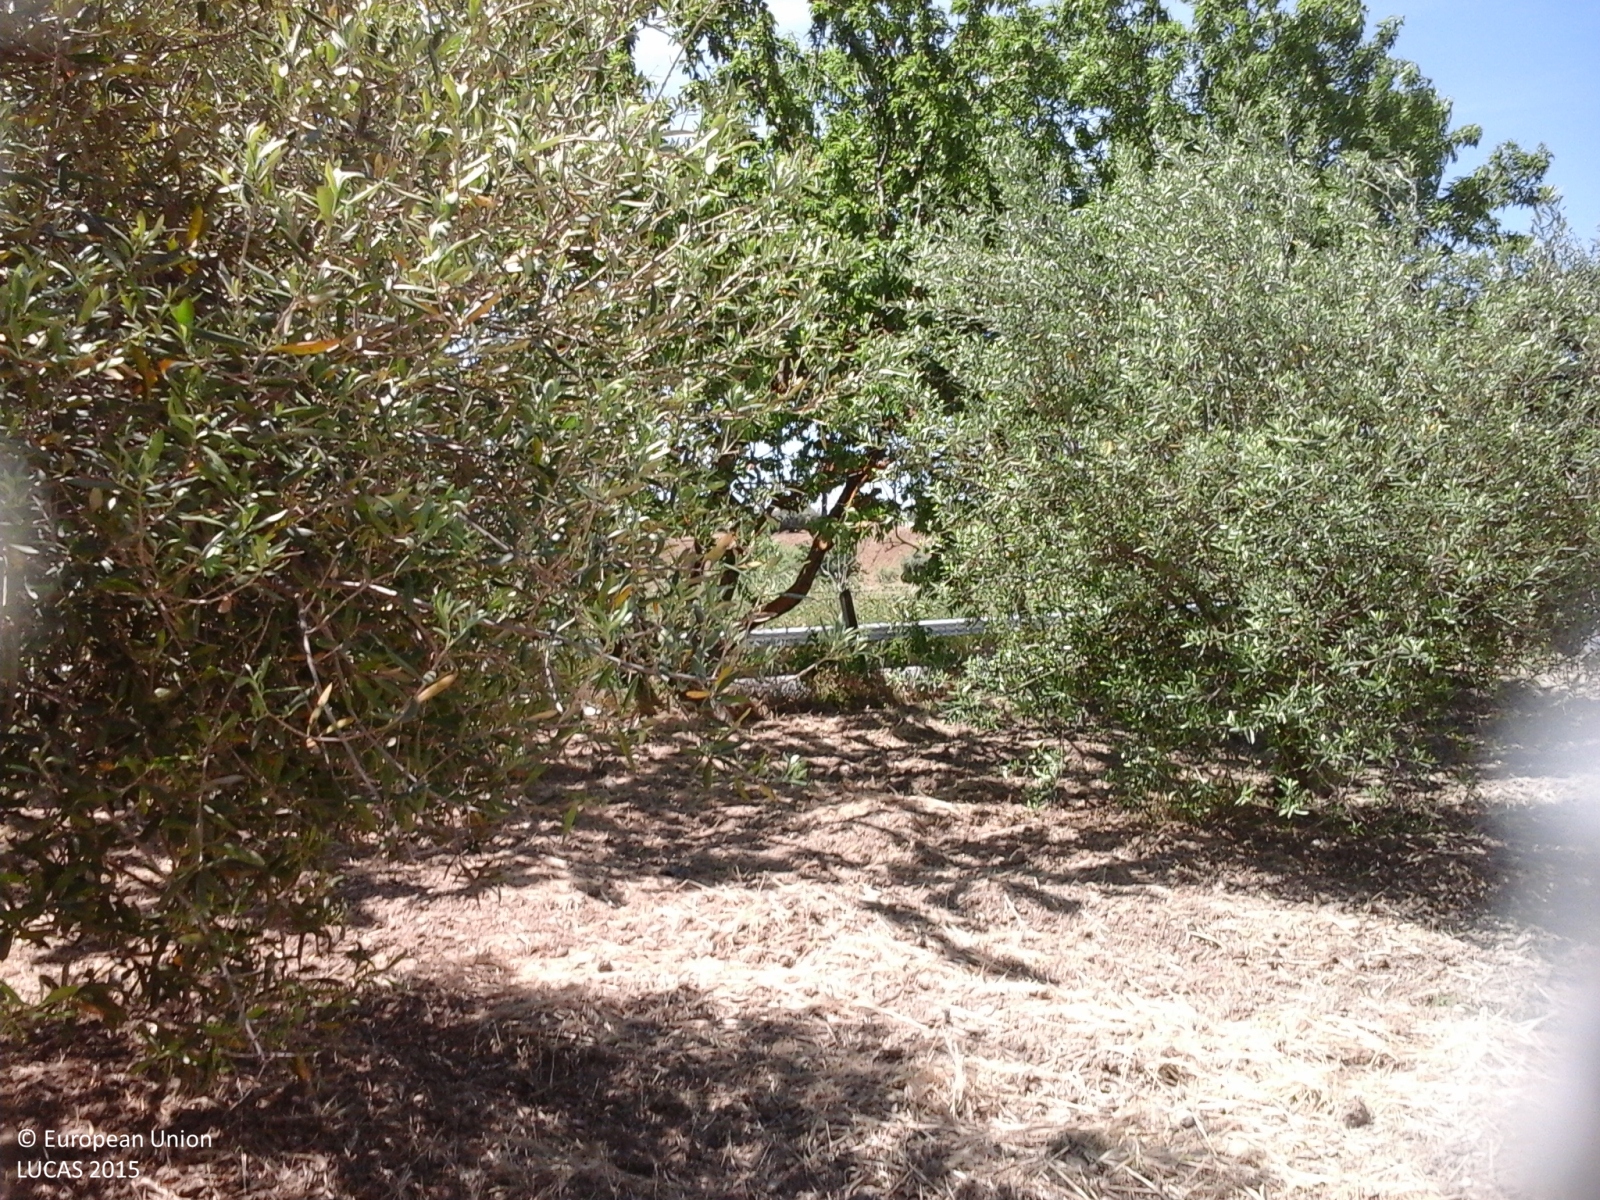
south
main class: Cropland
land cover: Olive groves
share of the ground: > 75 %
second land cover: Other bare soil
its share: > 75 %
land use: Agriculture (excluding fallow land and kitchen gardens)
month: May
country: IT
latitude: 37.4641
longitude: 13.9837
